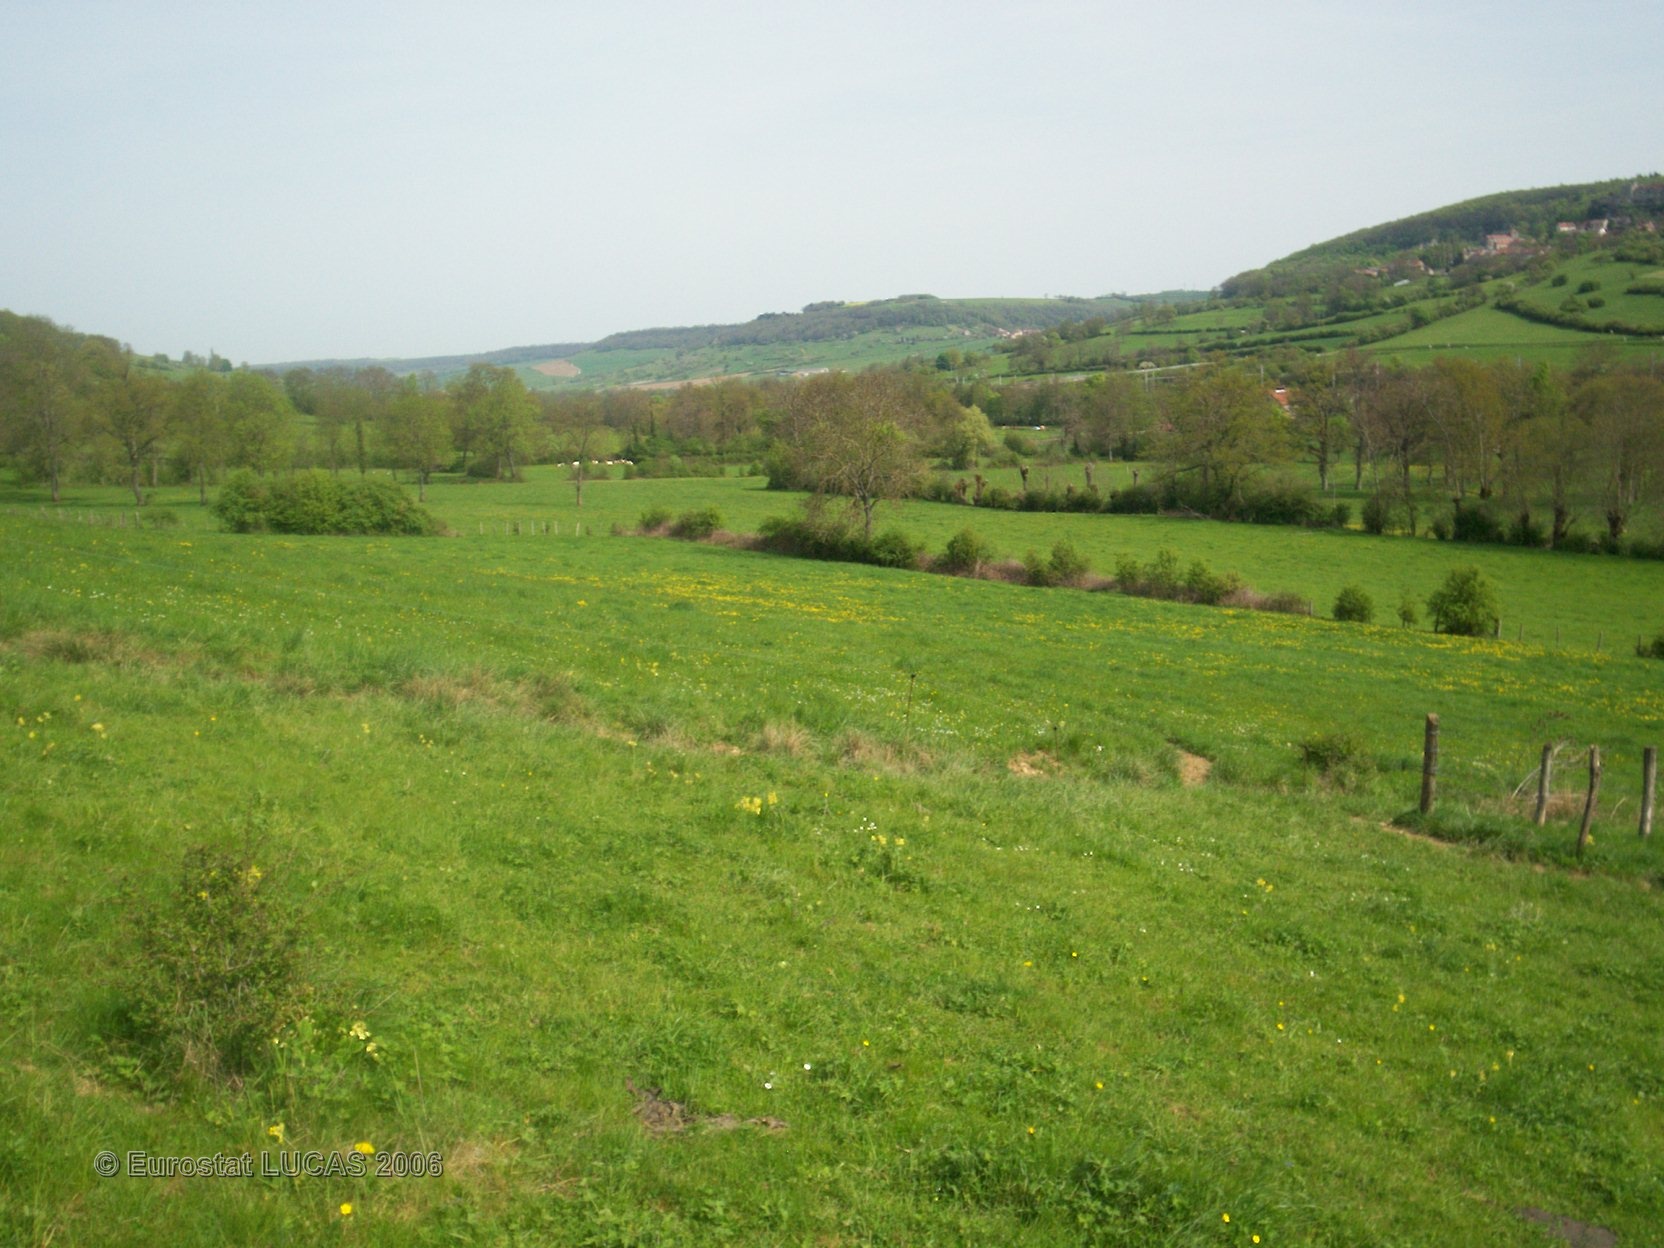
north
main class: Grassland
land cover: Grassland without tree/shrub cover
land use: Agriculture (excluding fallow land and kitchen gardens)
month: May
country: FR
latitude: 47.4446
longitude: 4.6552
